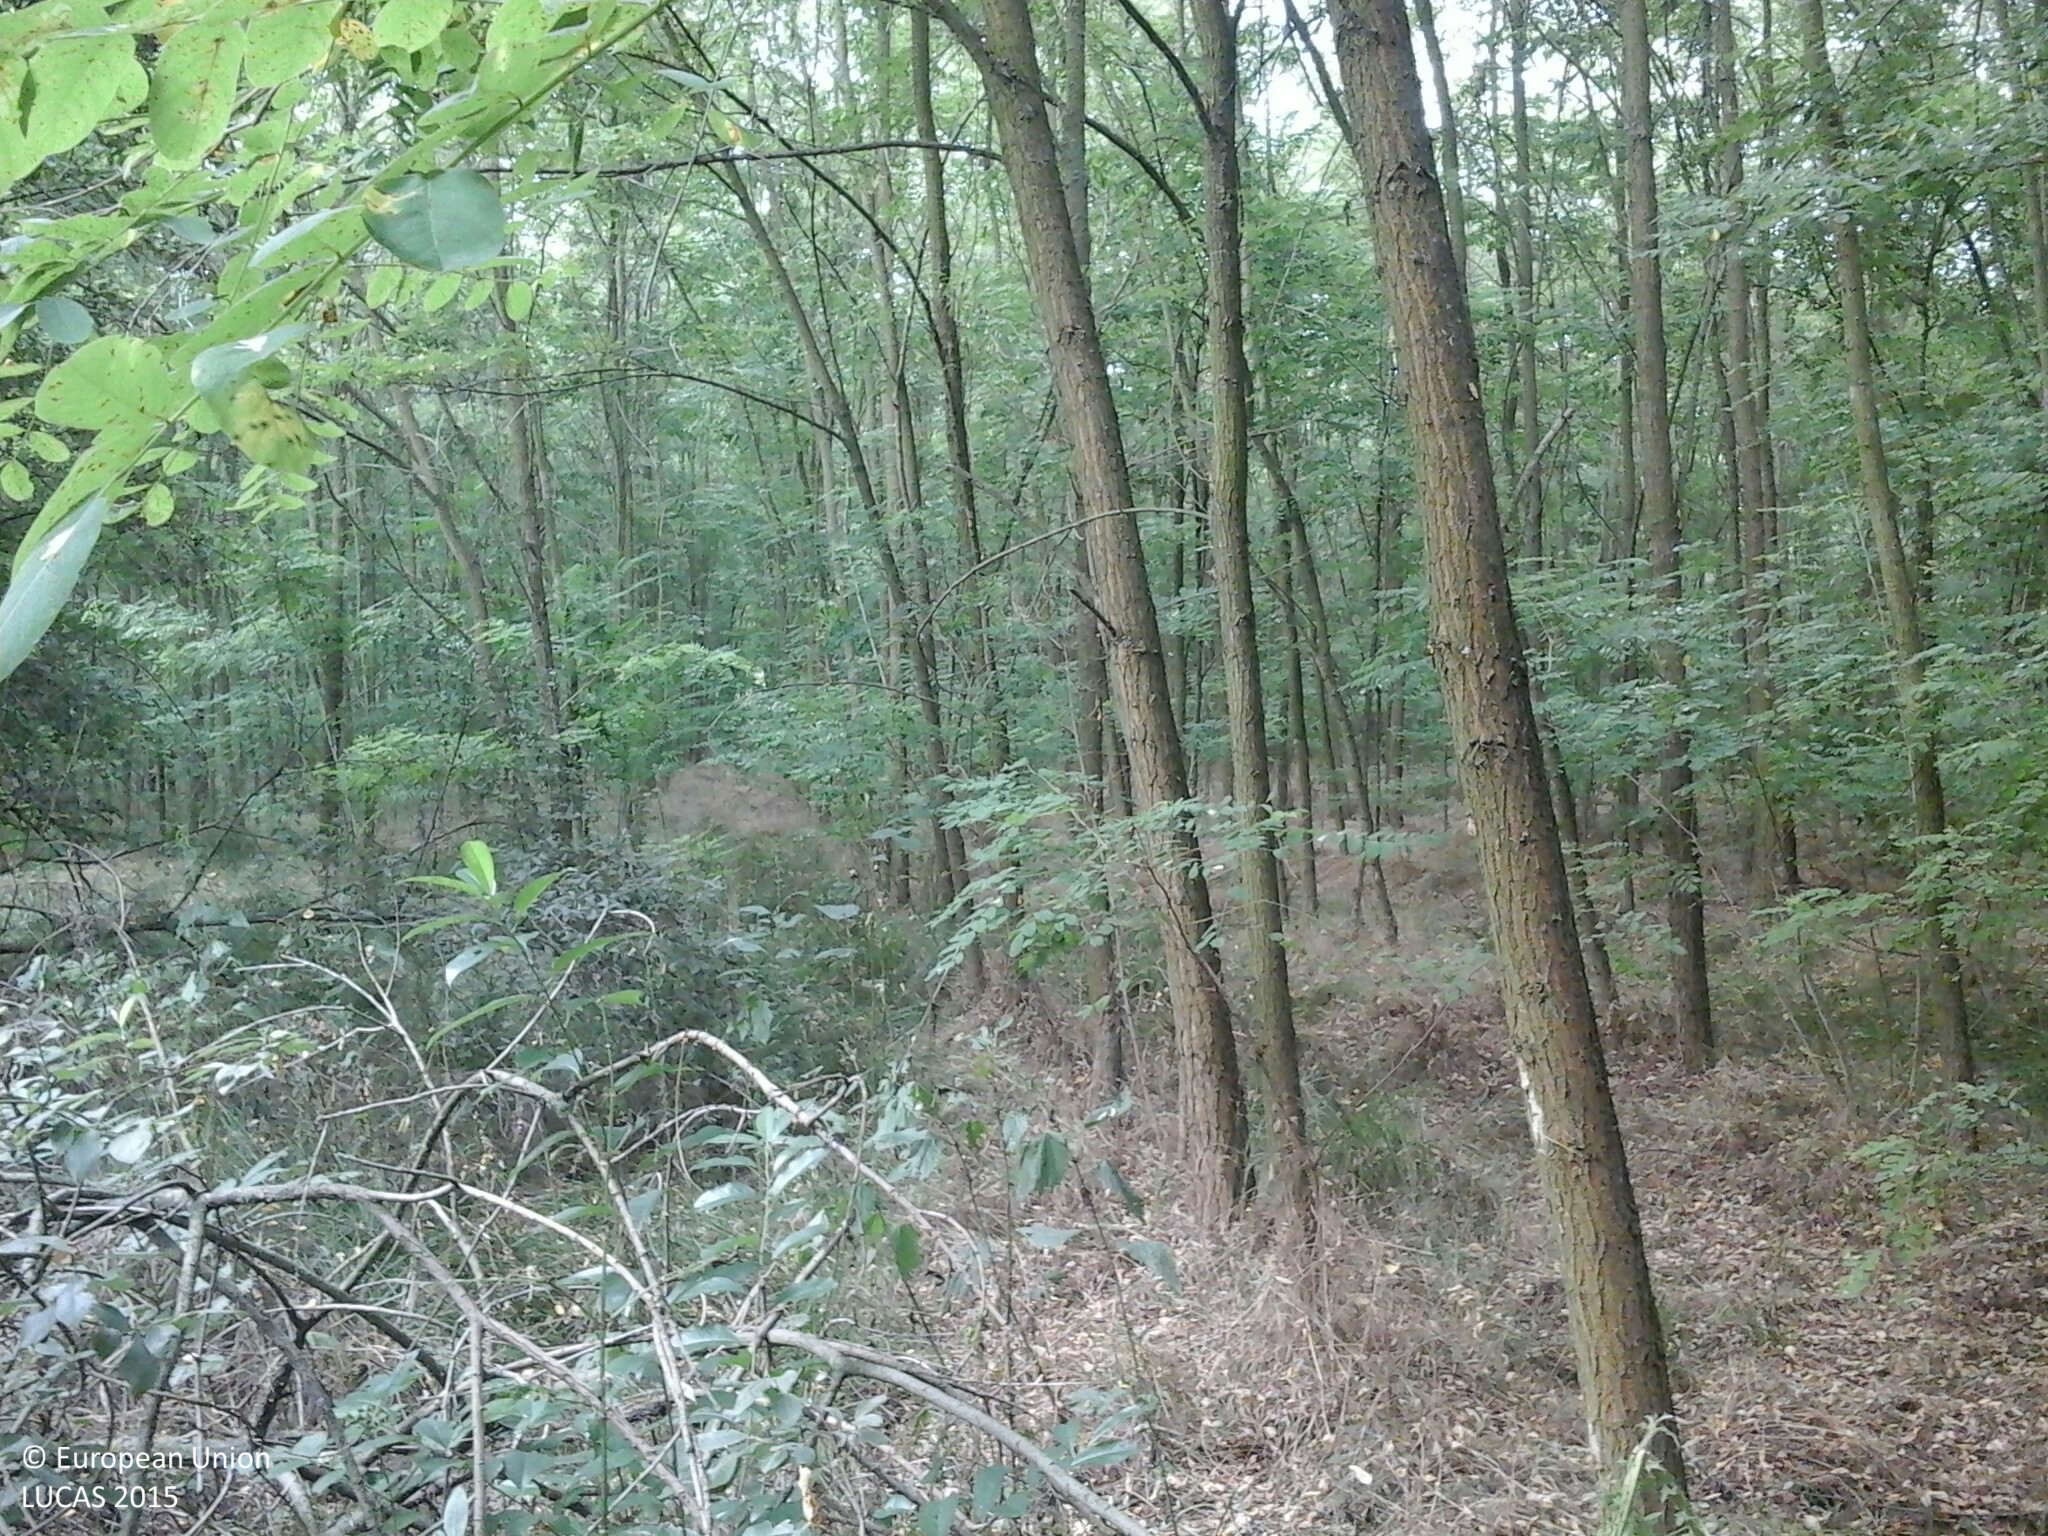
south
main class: Woodland
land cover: Broadleaved woodland
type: exotic forest
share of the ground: > 75 %
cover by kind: broadleaved forest trees 95 %, herbaceous plants 5 %
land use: Forestry
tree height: > 5 m
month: July
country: HU
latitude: 47.7871
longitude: 22.1328
